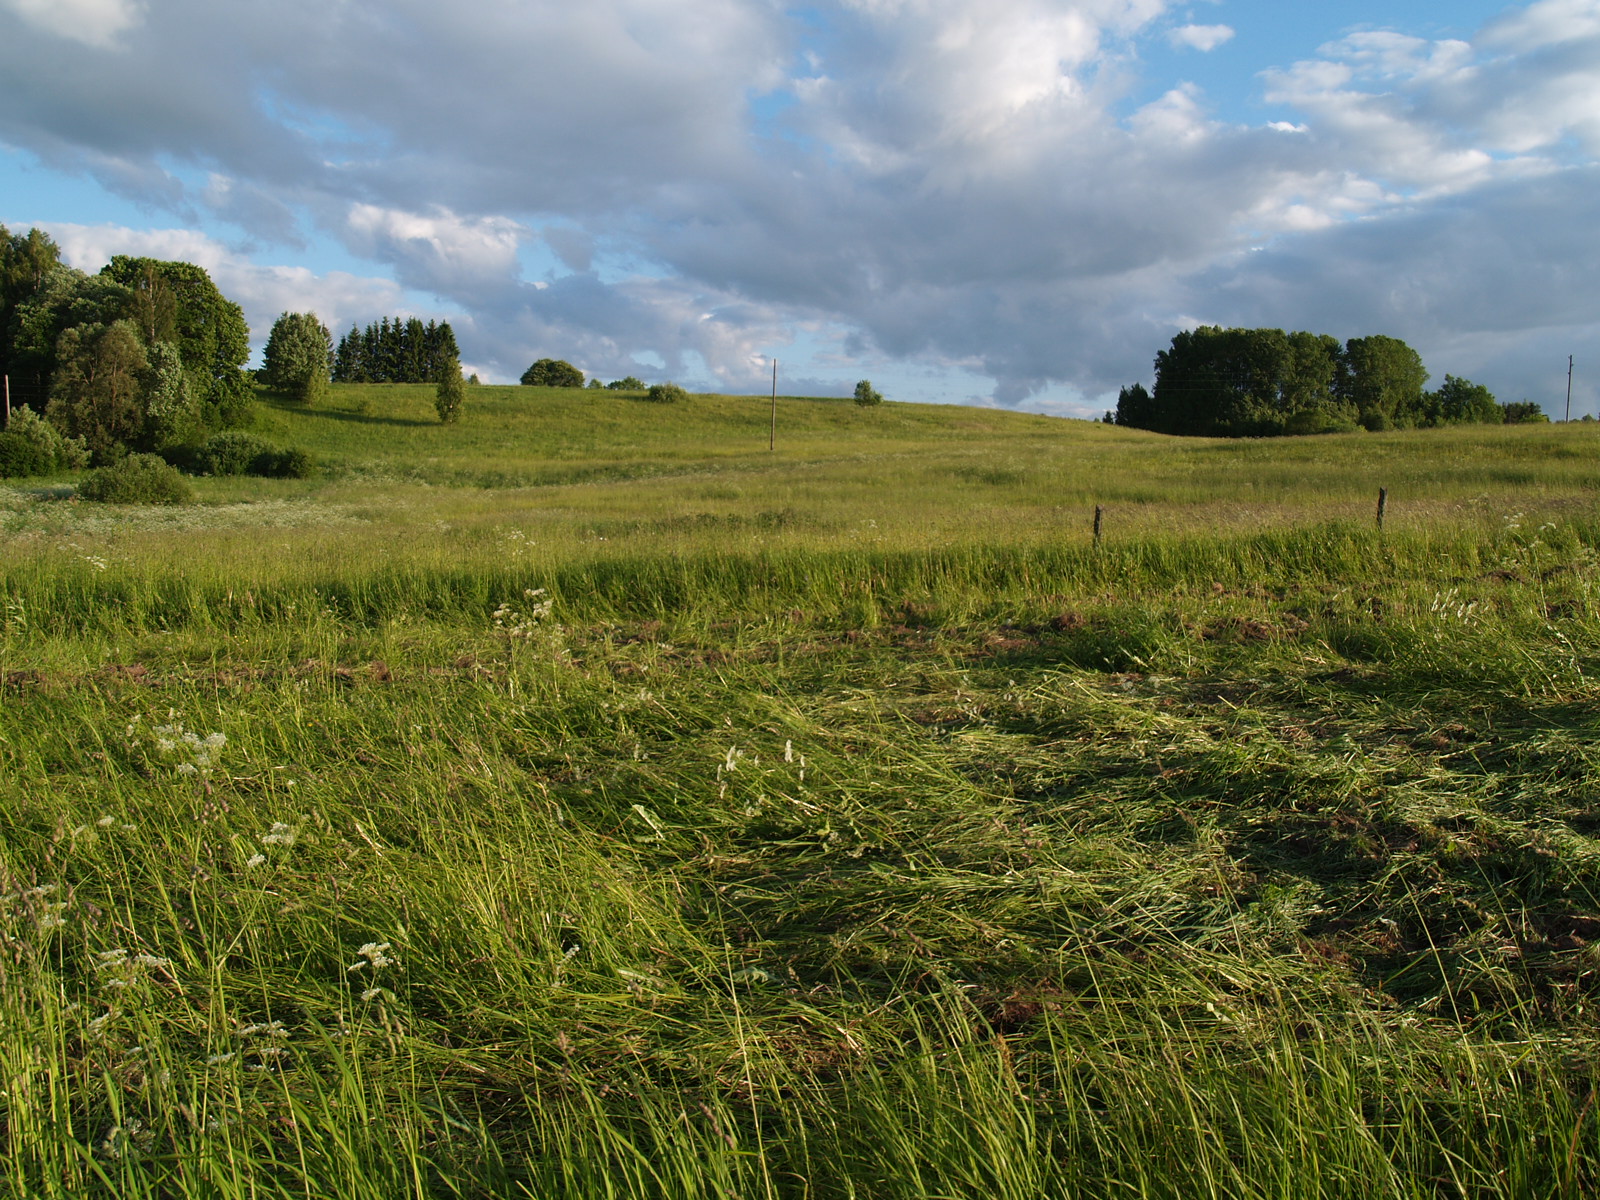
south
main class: Grassland
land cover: Grassland without tree/shrub cover
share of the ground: > 75 %
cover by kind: herbaceous plants 100 %
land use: Agriculture (excluding fallow land and kitchen gardens)
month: June
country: LV
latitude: 56.6488
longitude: 25.6666
